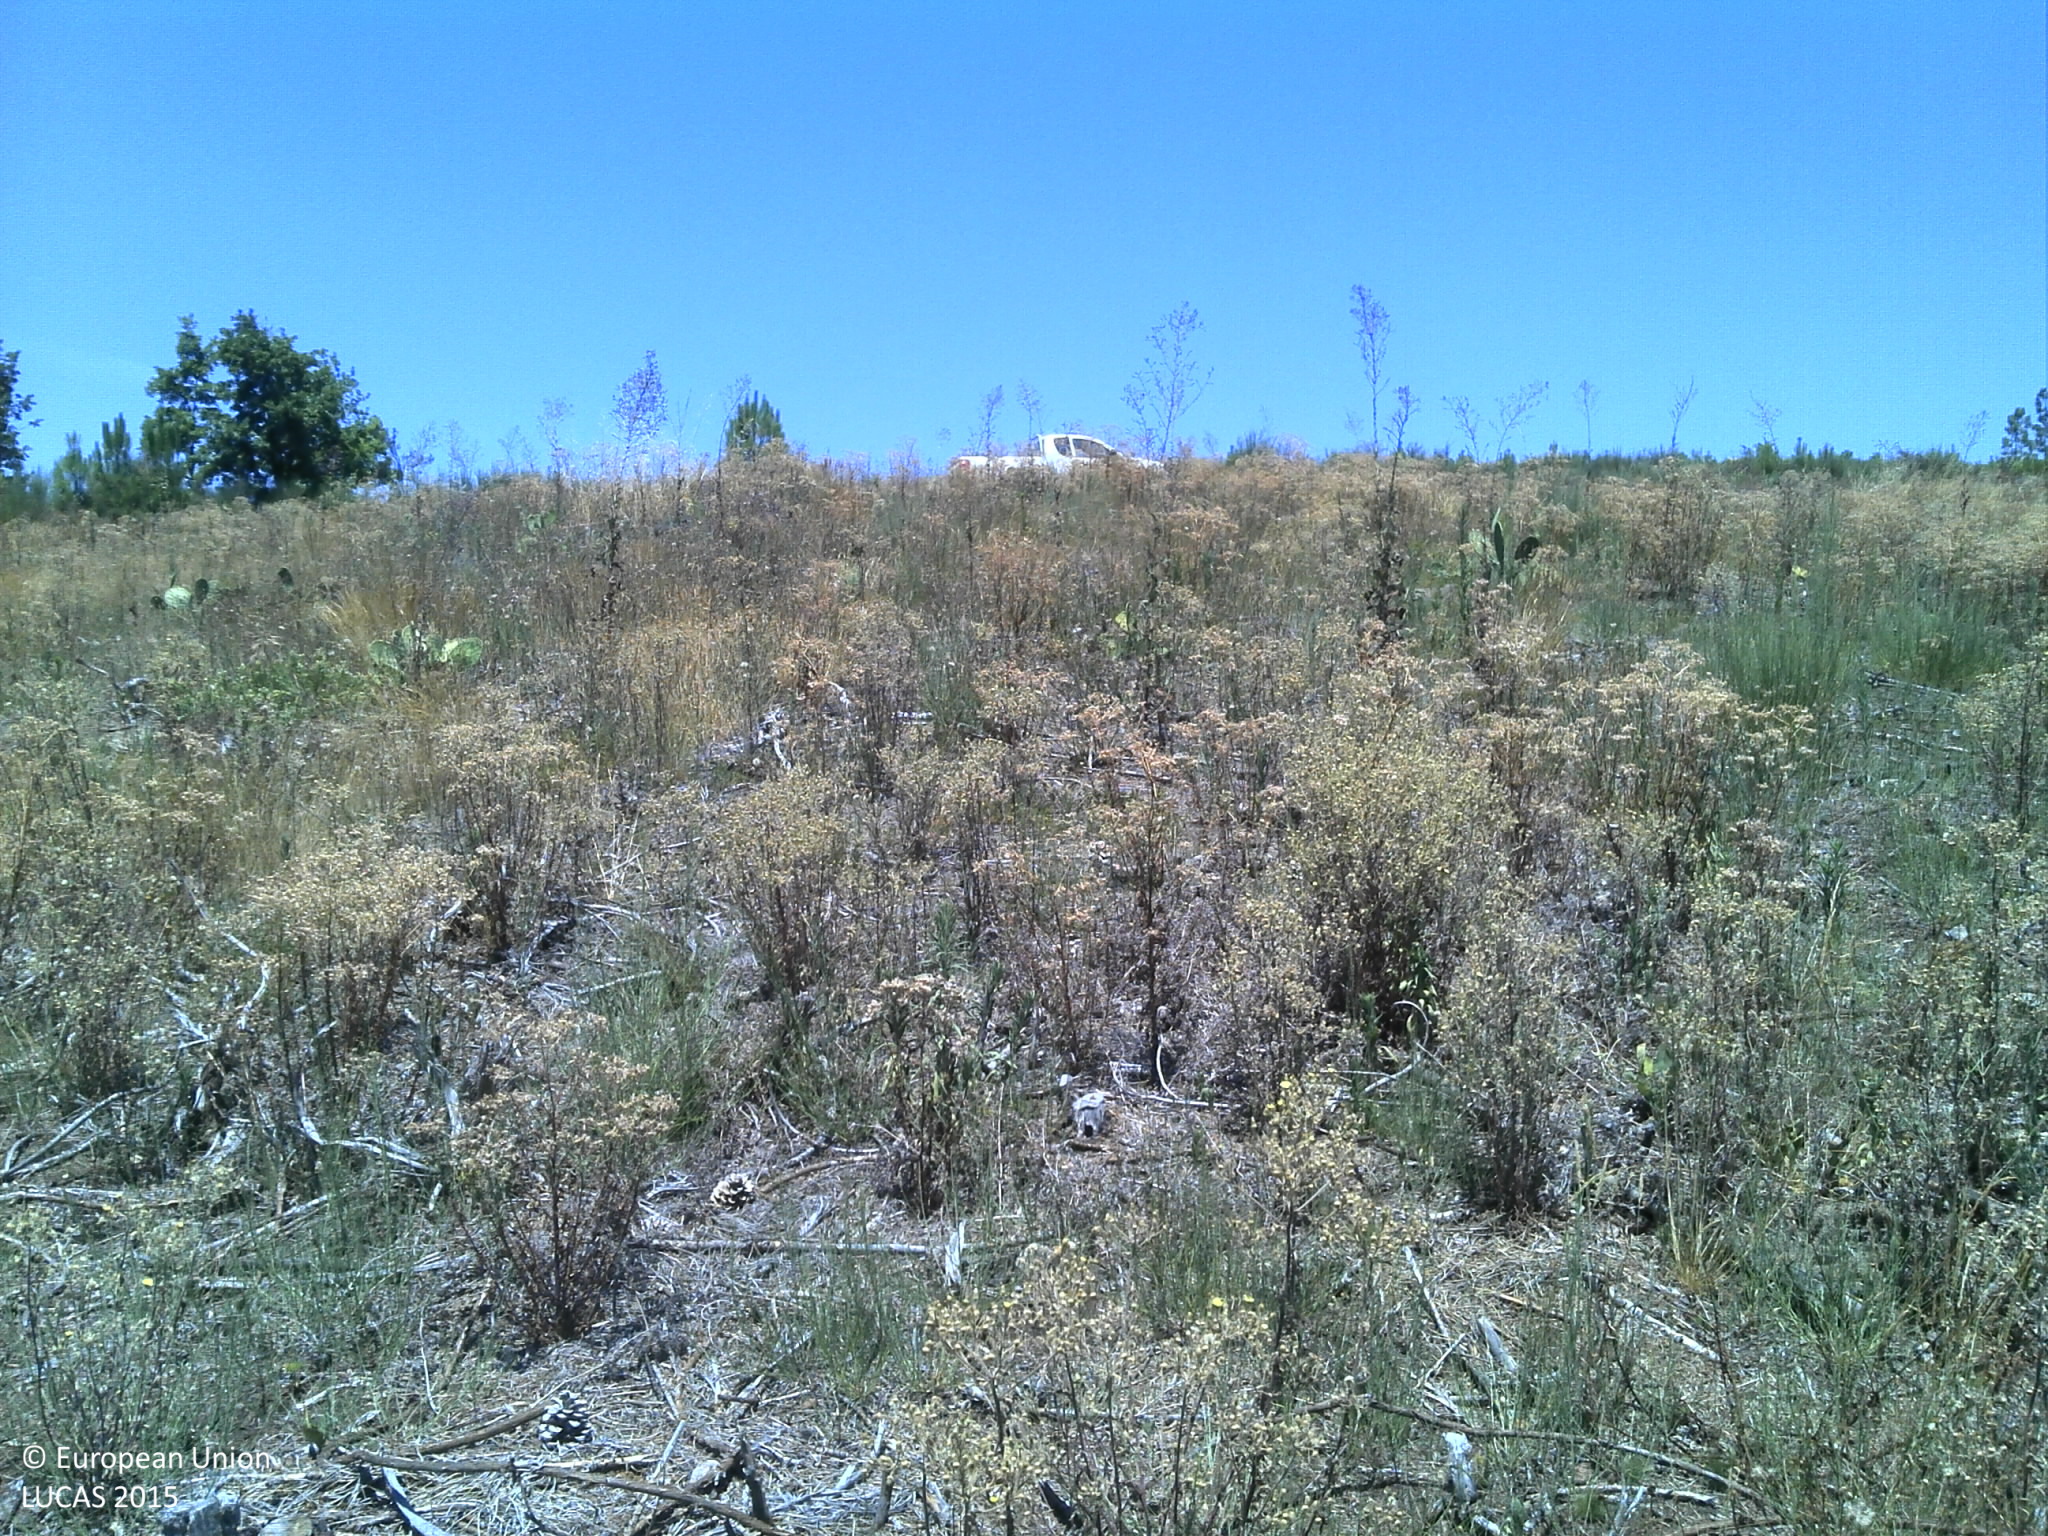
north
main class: Shrubland
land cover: Shrubland without tree cover
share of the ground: 50 - 75 %
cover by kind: shrubs 70 %, unconsolidated bare surface 20 %, herbaceous plants 10 %
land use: Agriculture (excluding fallow land and kitchen gardens)
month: July
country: PT
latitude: 40.2584
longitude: -7.9550
